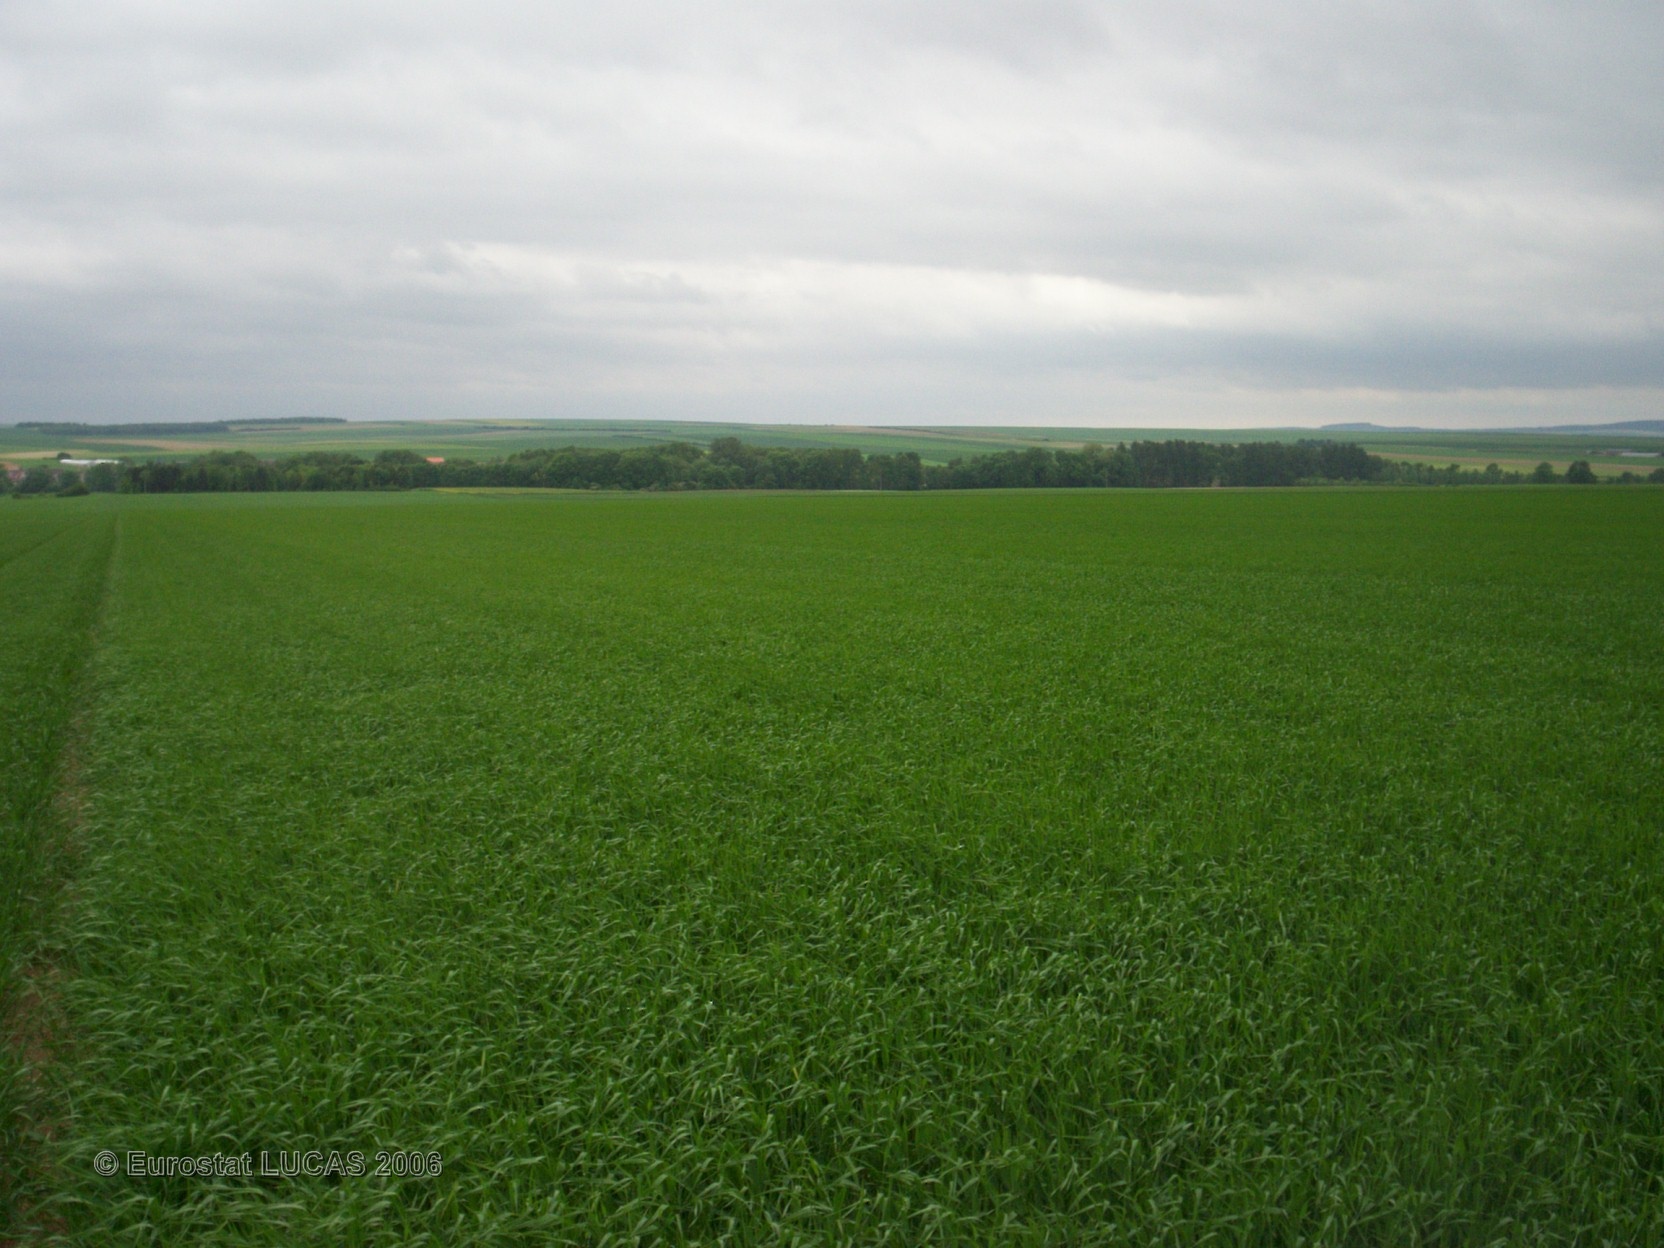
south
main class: Cropland
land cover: Barley
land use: Agriculture (excluding fallow land and kitchen gardens)
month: May
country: FR
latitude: 49.3102
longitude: 4.4531
